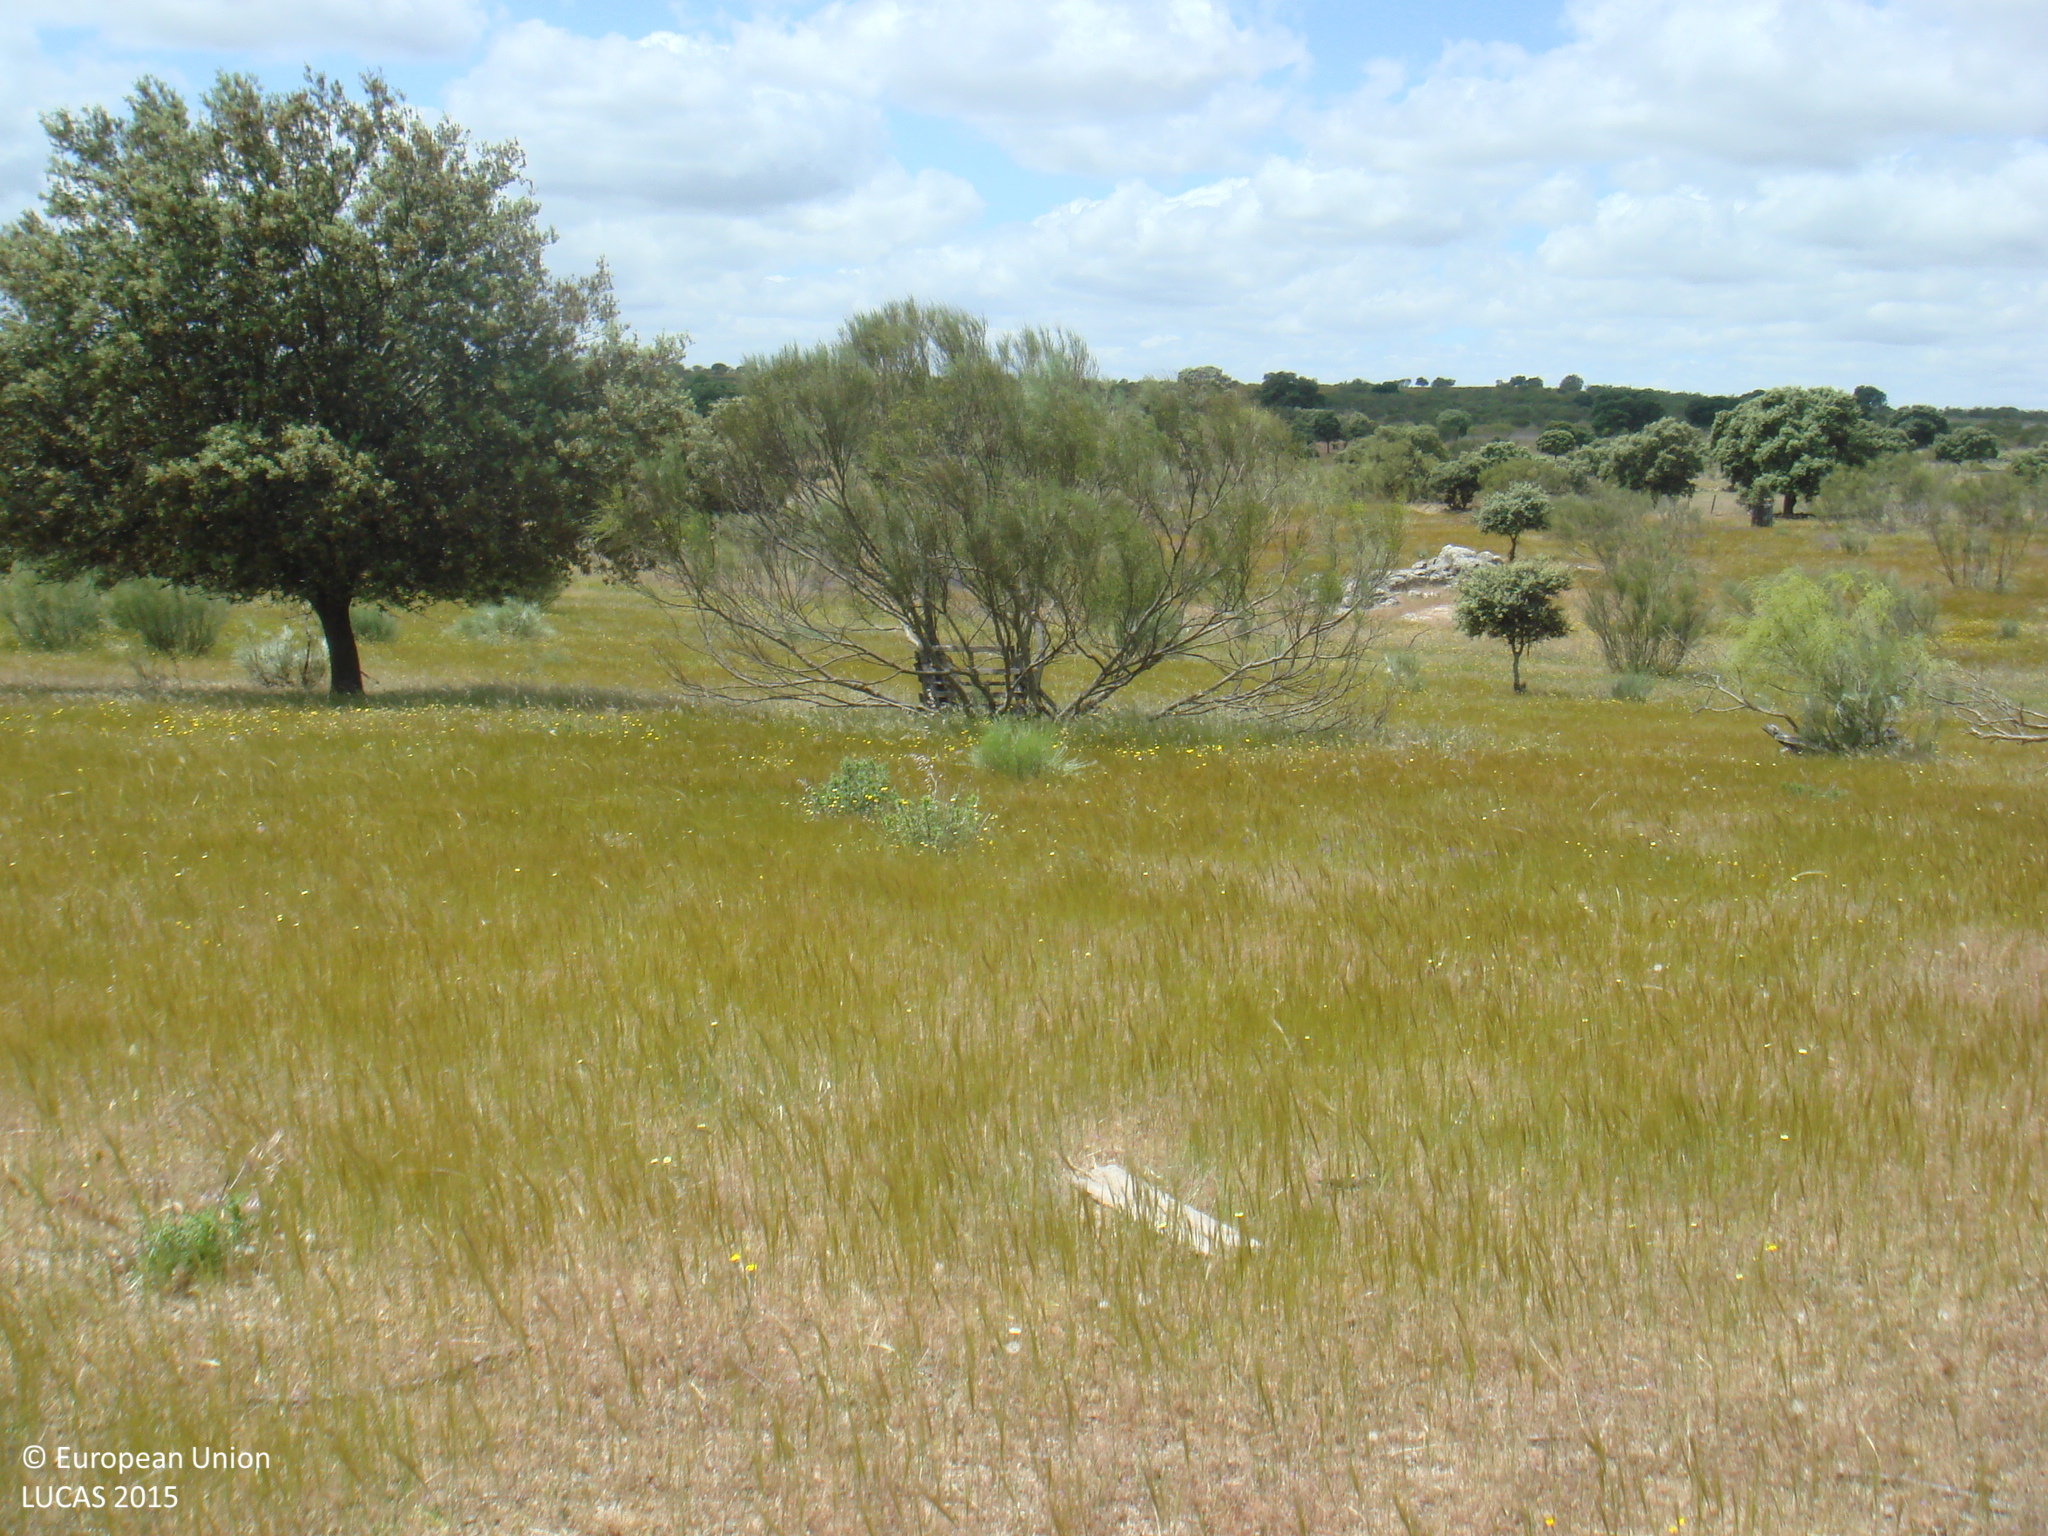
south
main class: Woodland
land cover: Broadleaved woodland
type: broadleaved evergreen forest
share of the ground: 25 - 50 %
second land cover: Shrubland without tree cover
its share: 10 - 25 %
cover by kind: broadleaved forest trees 40 %, herbaceous plants 40 %, shrubs 20 %
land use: Forestry
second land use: Agriculture (excluding fallow land and kitchen gardens)
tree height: > 5 m
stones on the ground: < 10 %
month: May
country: ES
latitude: 38.4408
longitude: -4.6755
